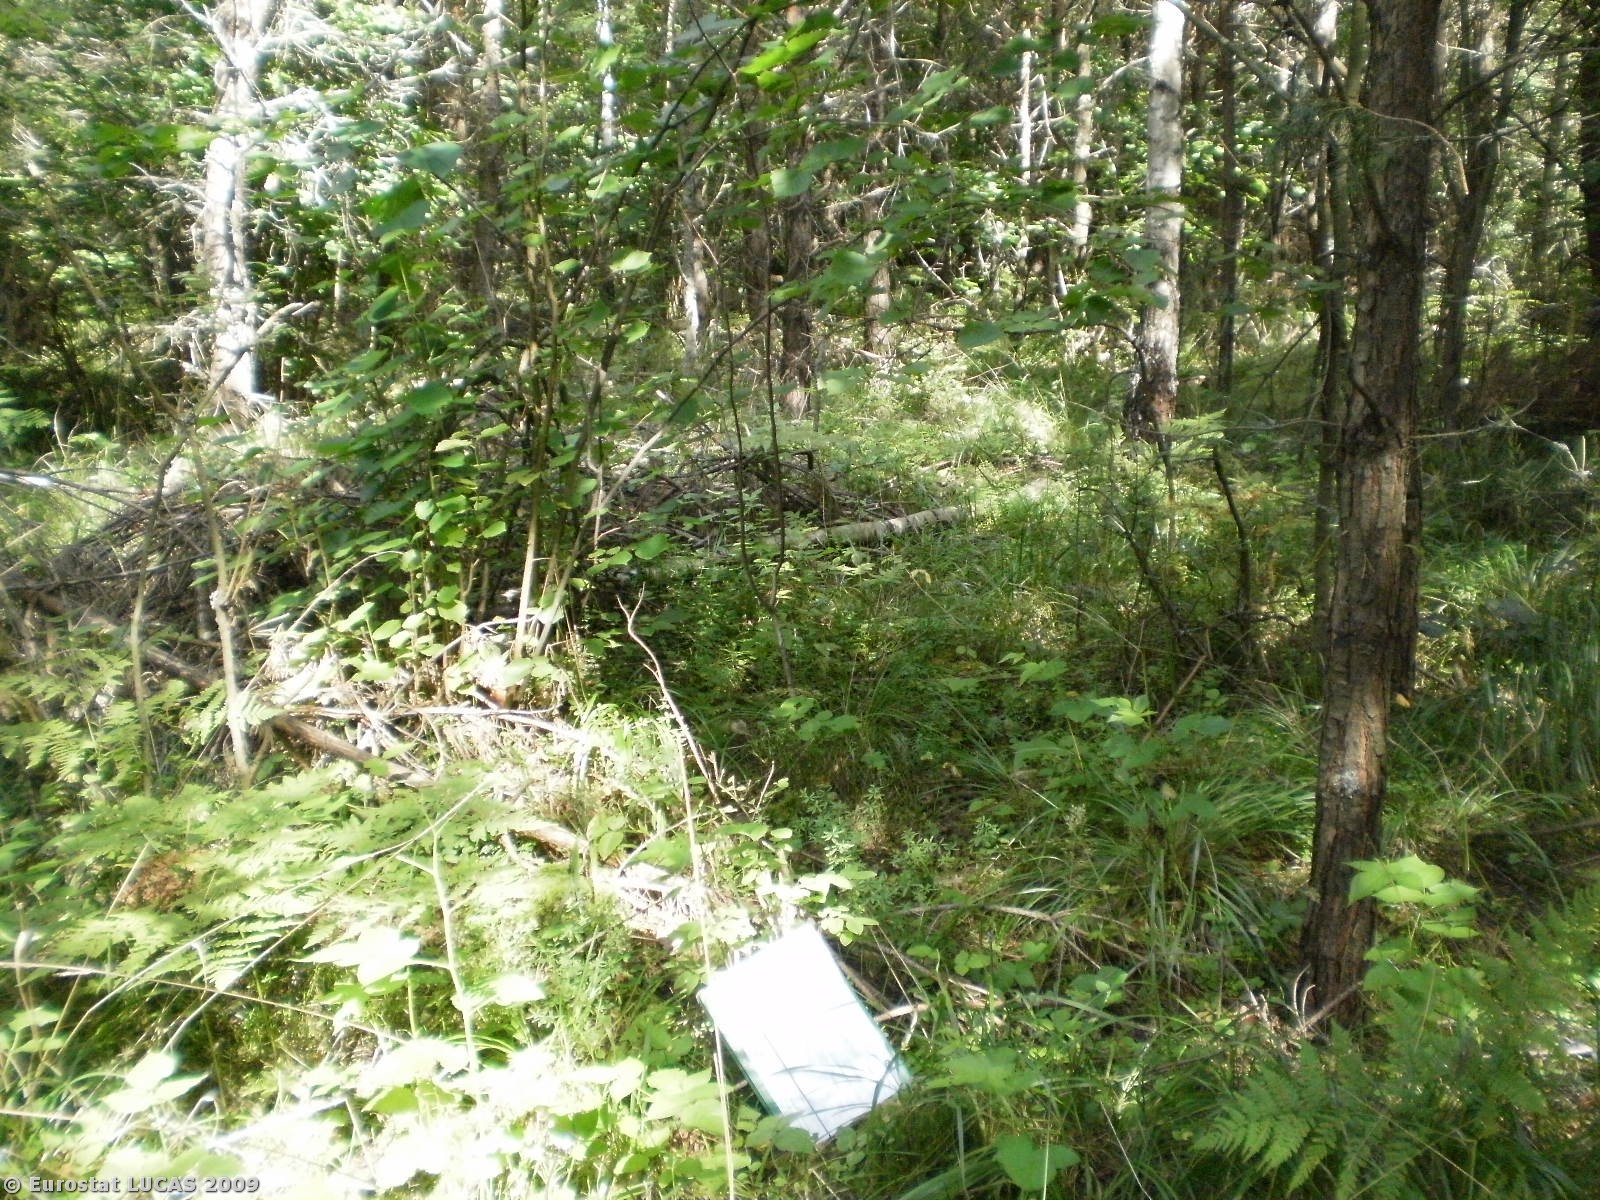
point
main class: Woodland
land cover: Mixed woodland
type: hemiboreal forest and nemoral coniferous forest and mixed broadleaved-coniferous forest
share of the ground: > 75 %
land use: Forestry
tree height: > 5 m
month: July
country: PL
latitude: 53.4136
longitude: 20.5239
